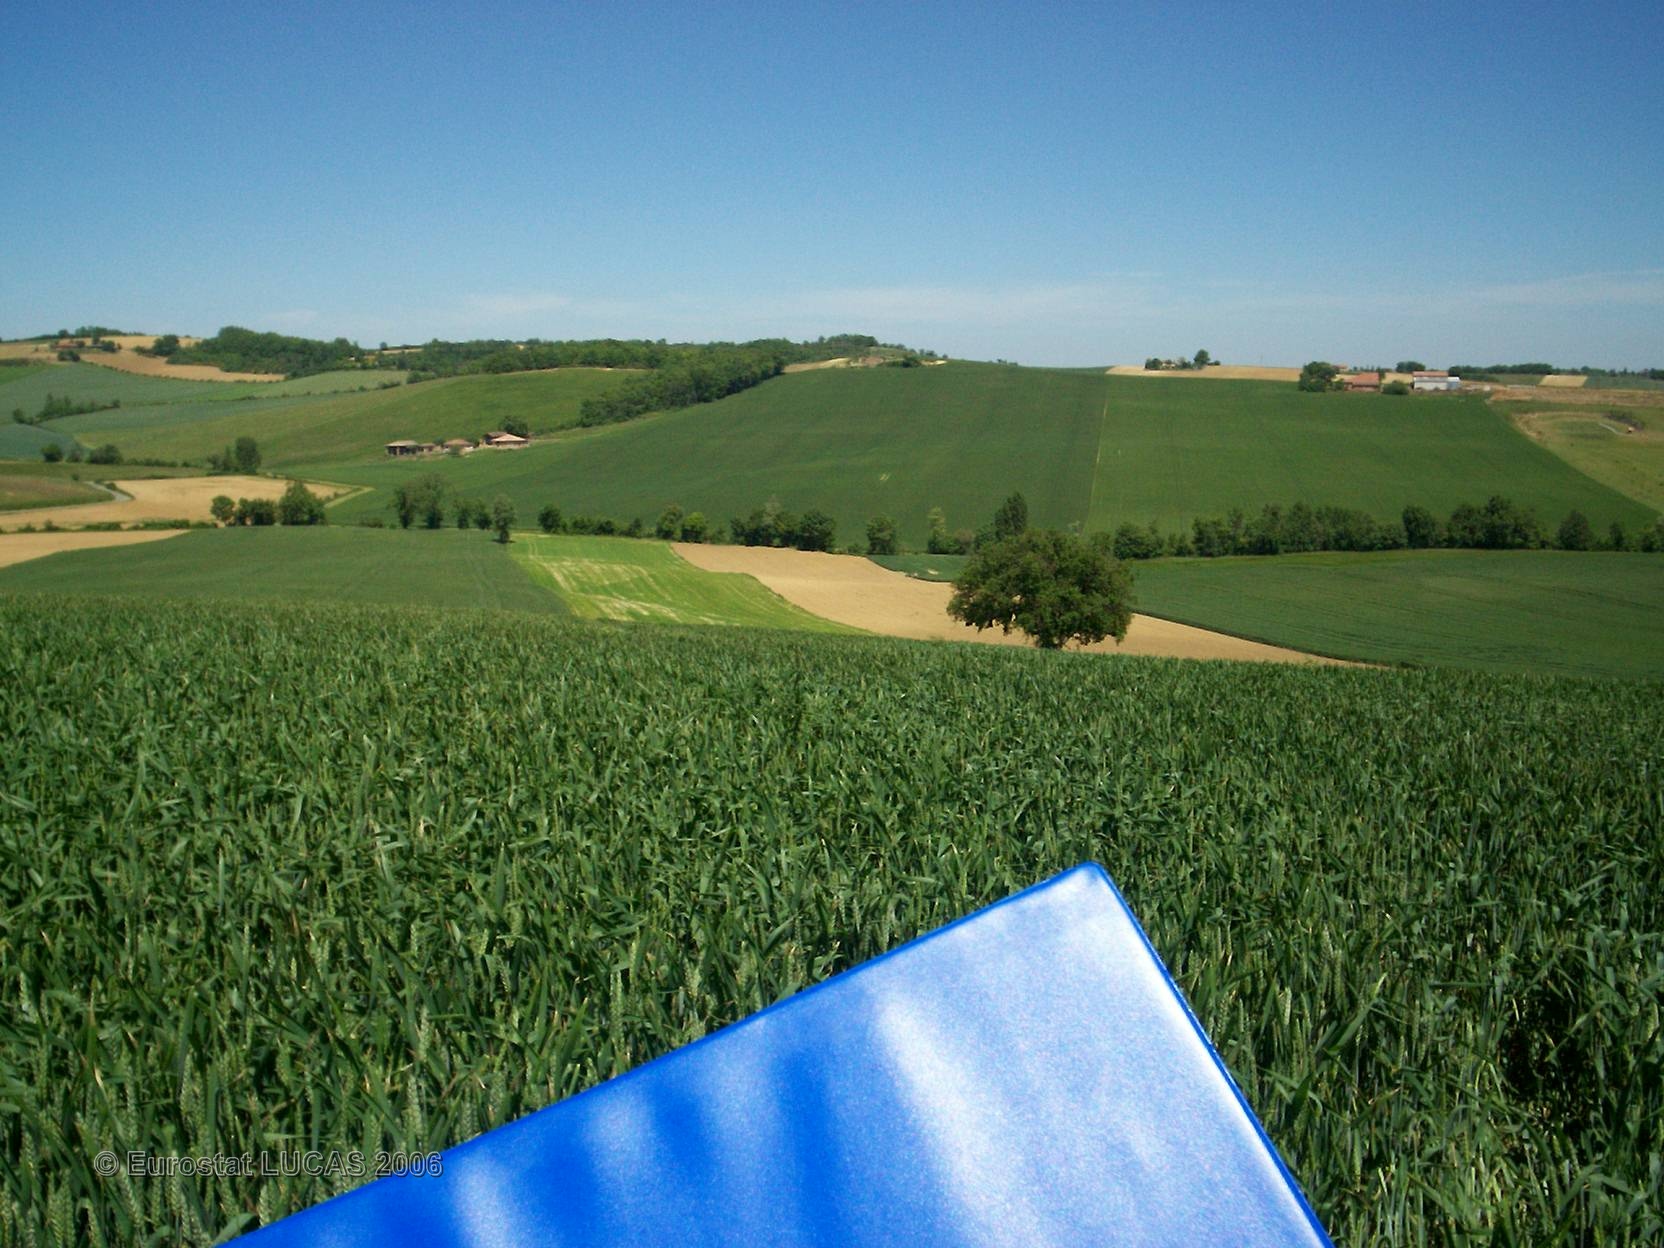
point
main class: Cropland
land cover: Durum wheat
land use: Agriculture (excluding fallow land and kitchen gardens)
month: May
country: FR
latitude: 43.4572
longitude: 0.8674
